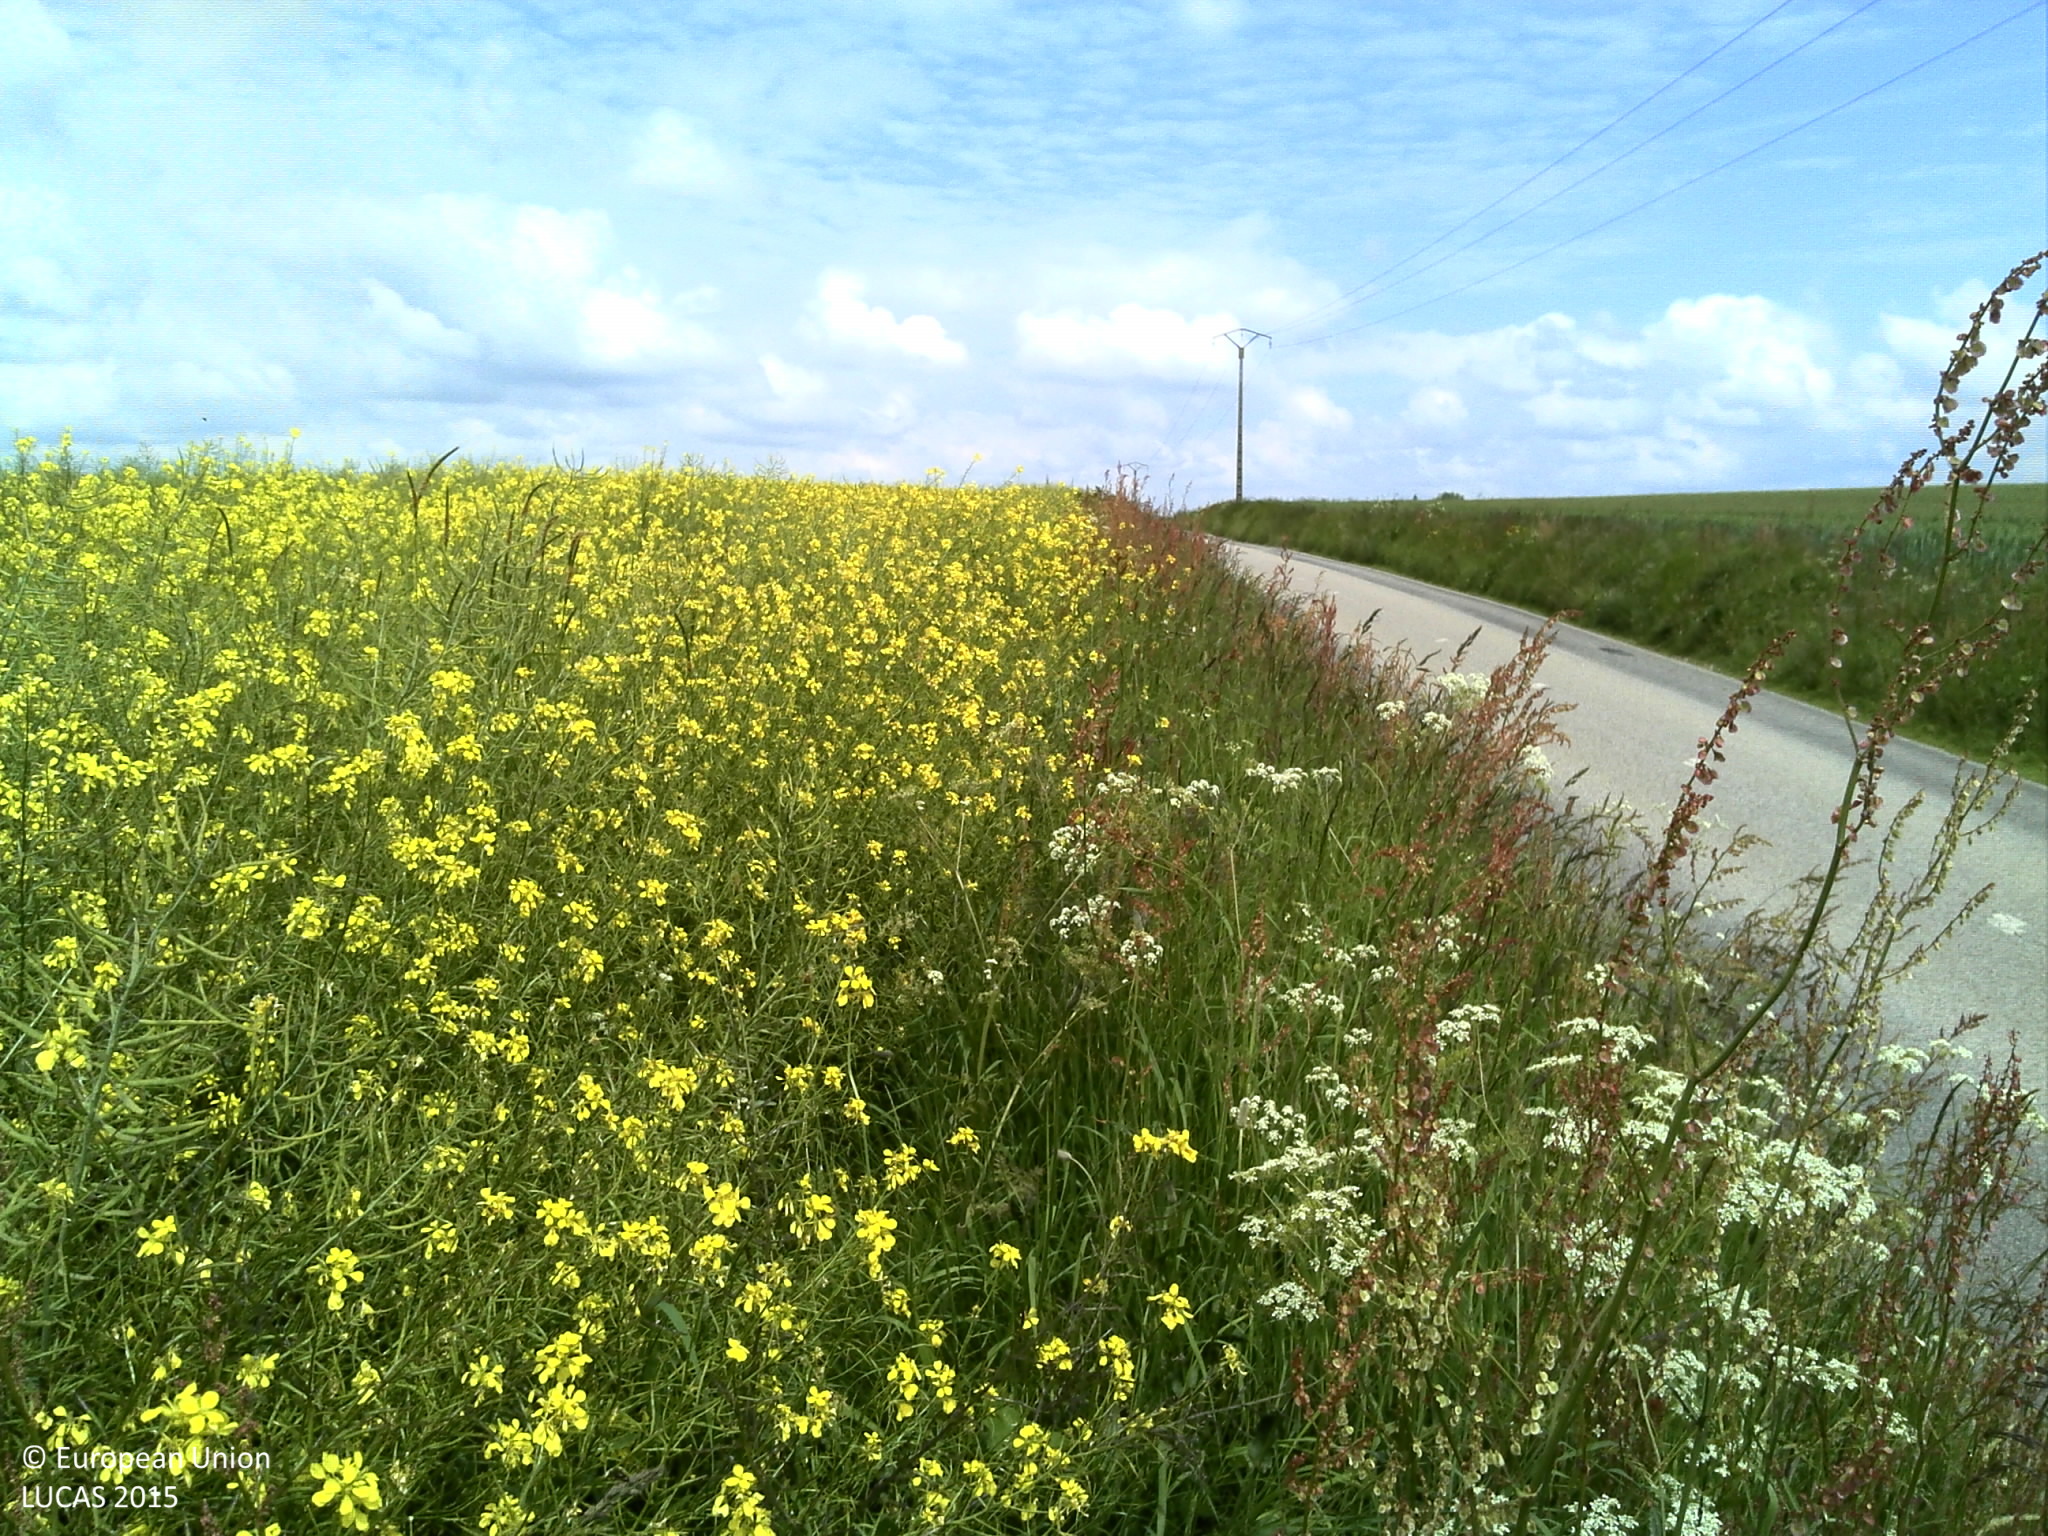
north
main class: Cropland
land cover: Rape and turnip rape
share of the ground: > 75 %
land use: Agriculture (excluding fallow land and kitchen gardens)
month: May
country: FR
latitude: 49.5341
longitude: 1.1772
